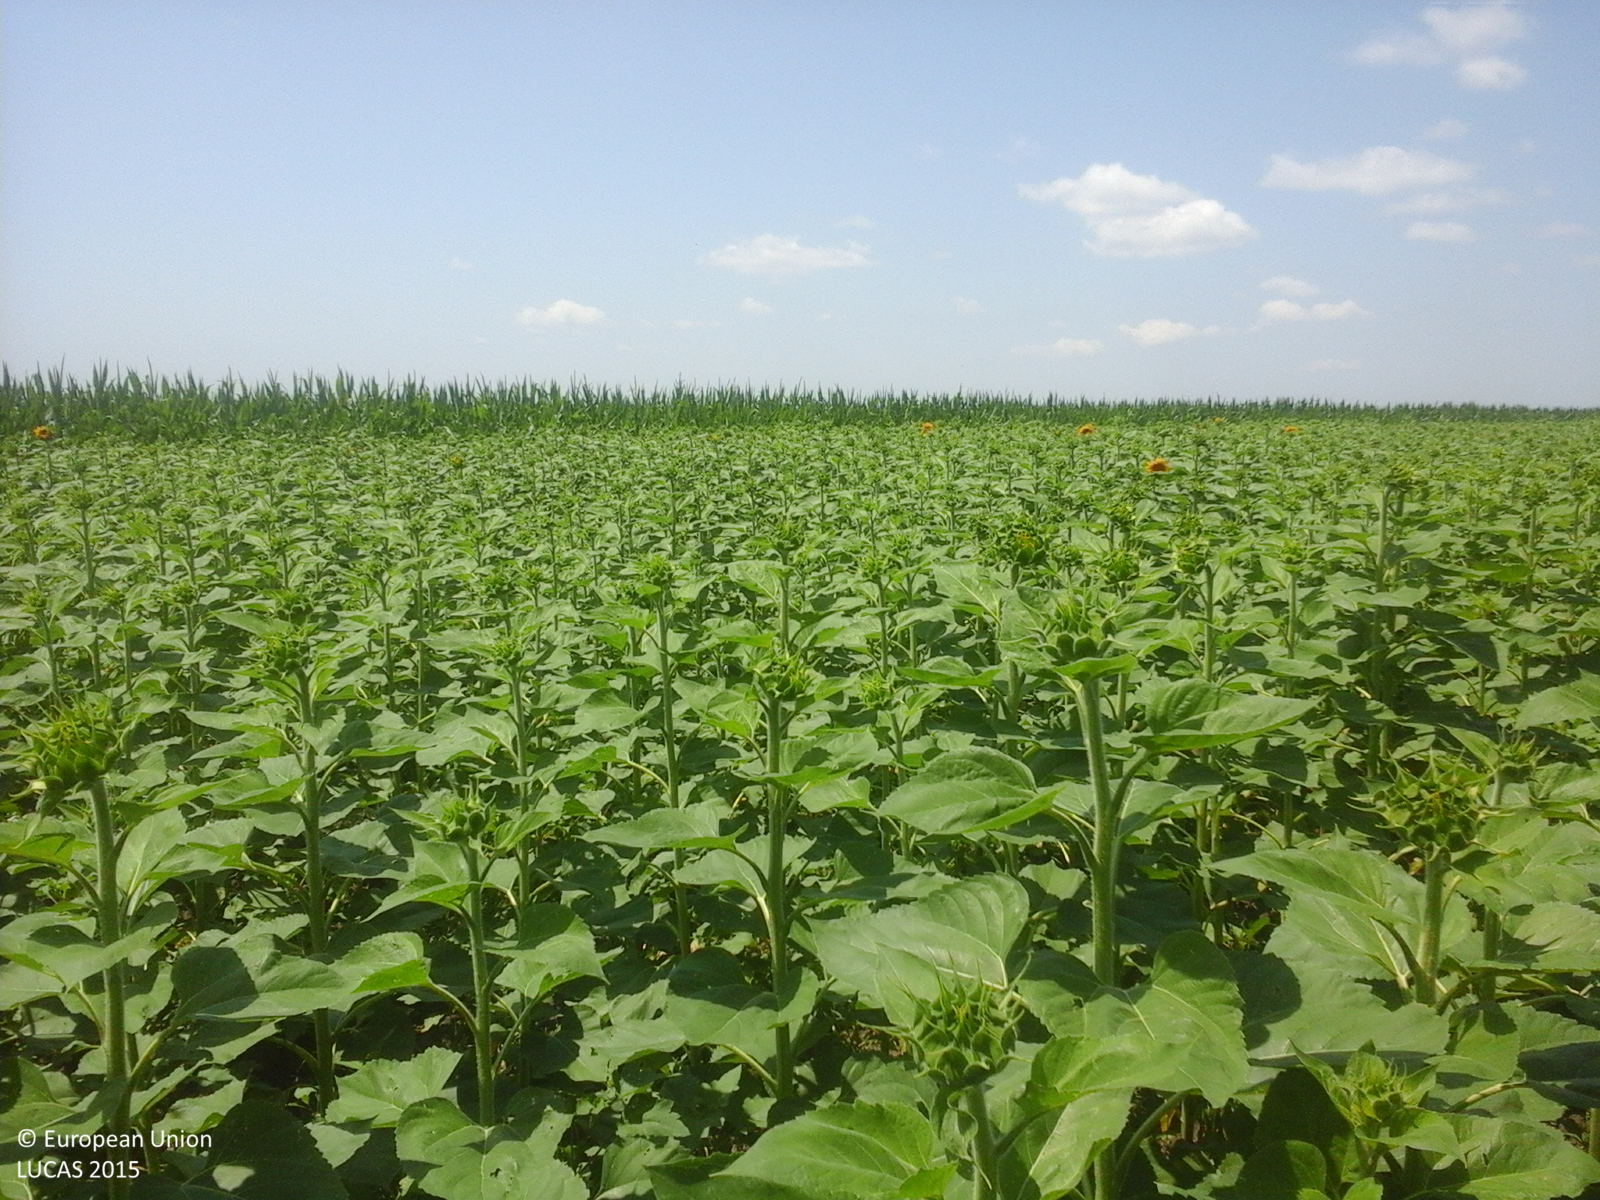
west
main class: Cropland
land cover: Sunflower
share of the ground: > 75 %
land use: Agriculture (excluding fallow land and kitchen gardens)
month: July
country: RO
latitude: 44.1148
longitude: 24.0920
